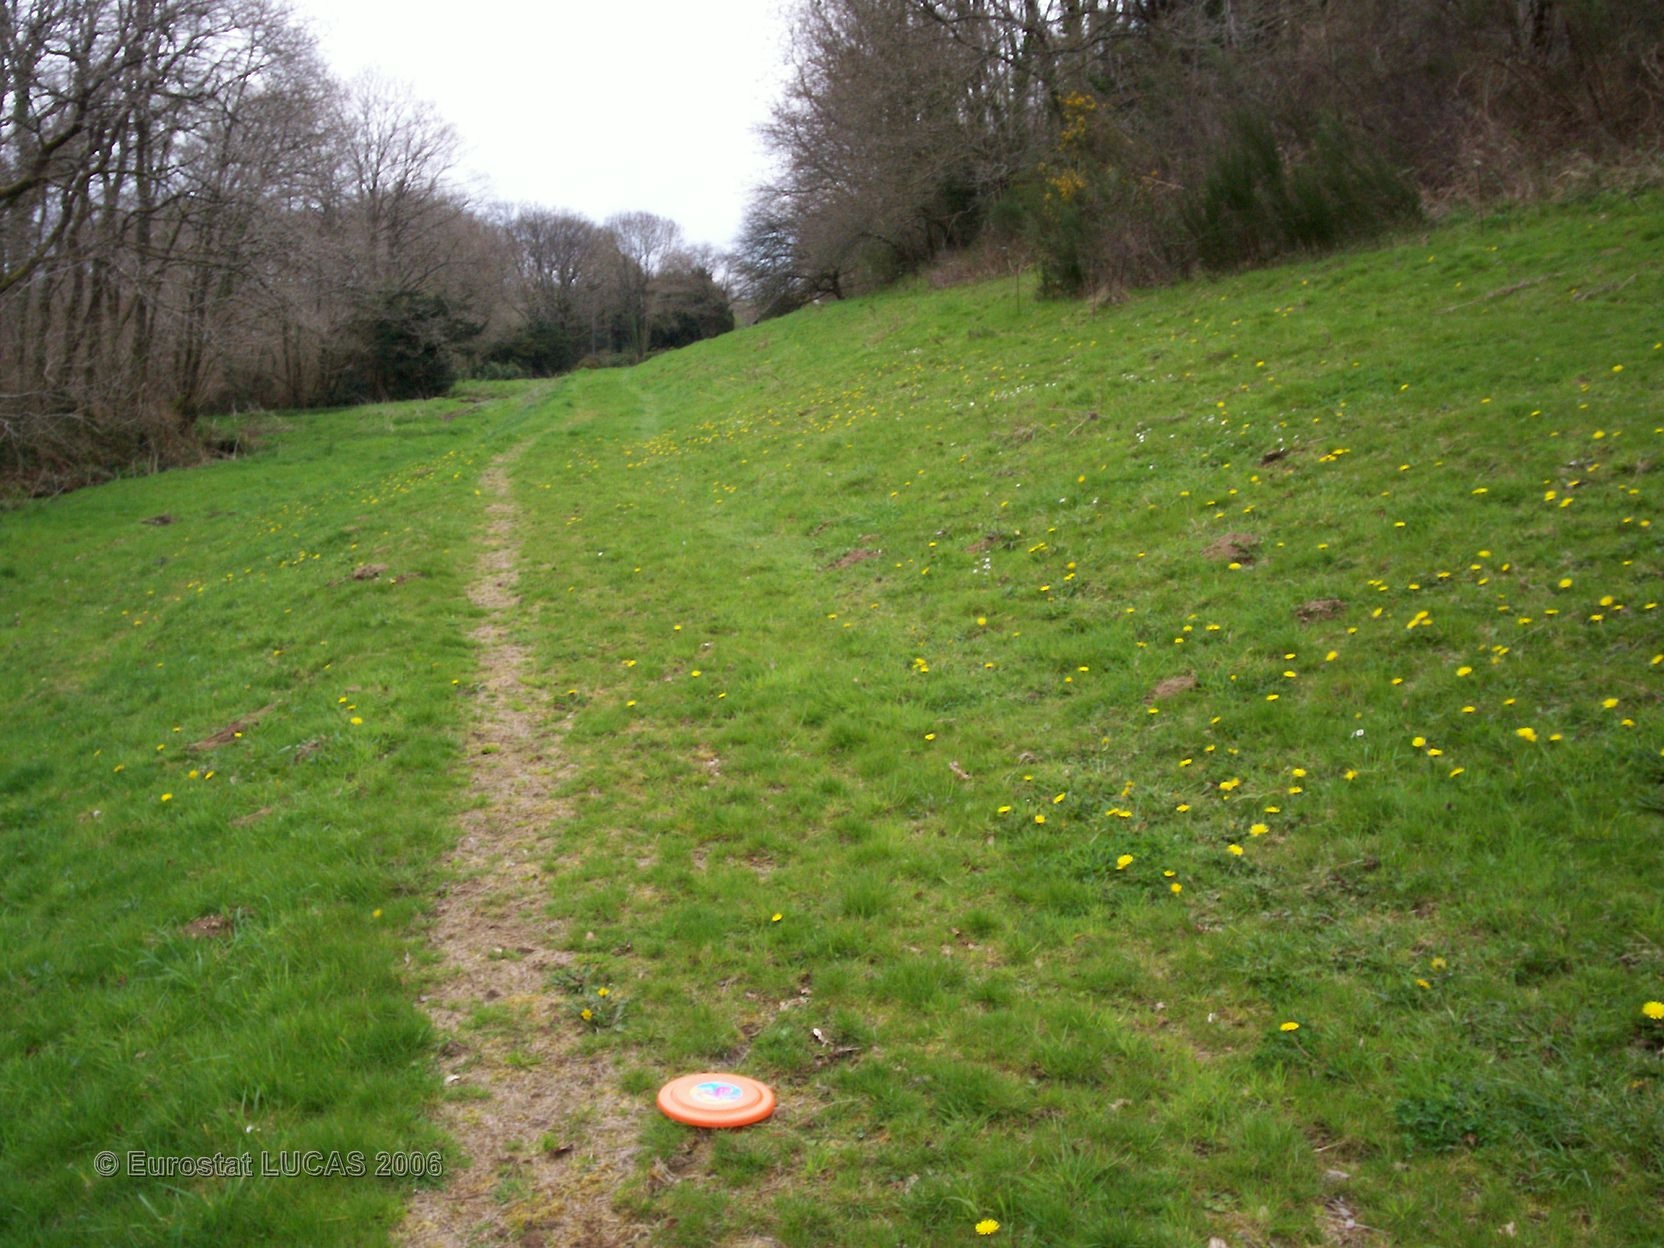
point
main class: Grassland
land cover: Grassland without tree/shrub cover
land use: Agriculture (excluding fallow land and kitchen gardens)
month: April
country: FR
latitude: 48.4489
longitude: -3.9179
